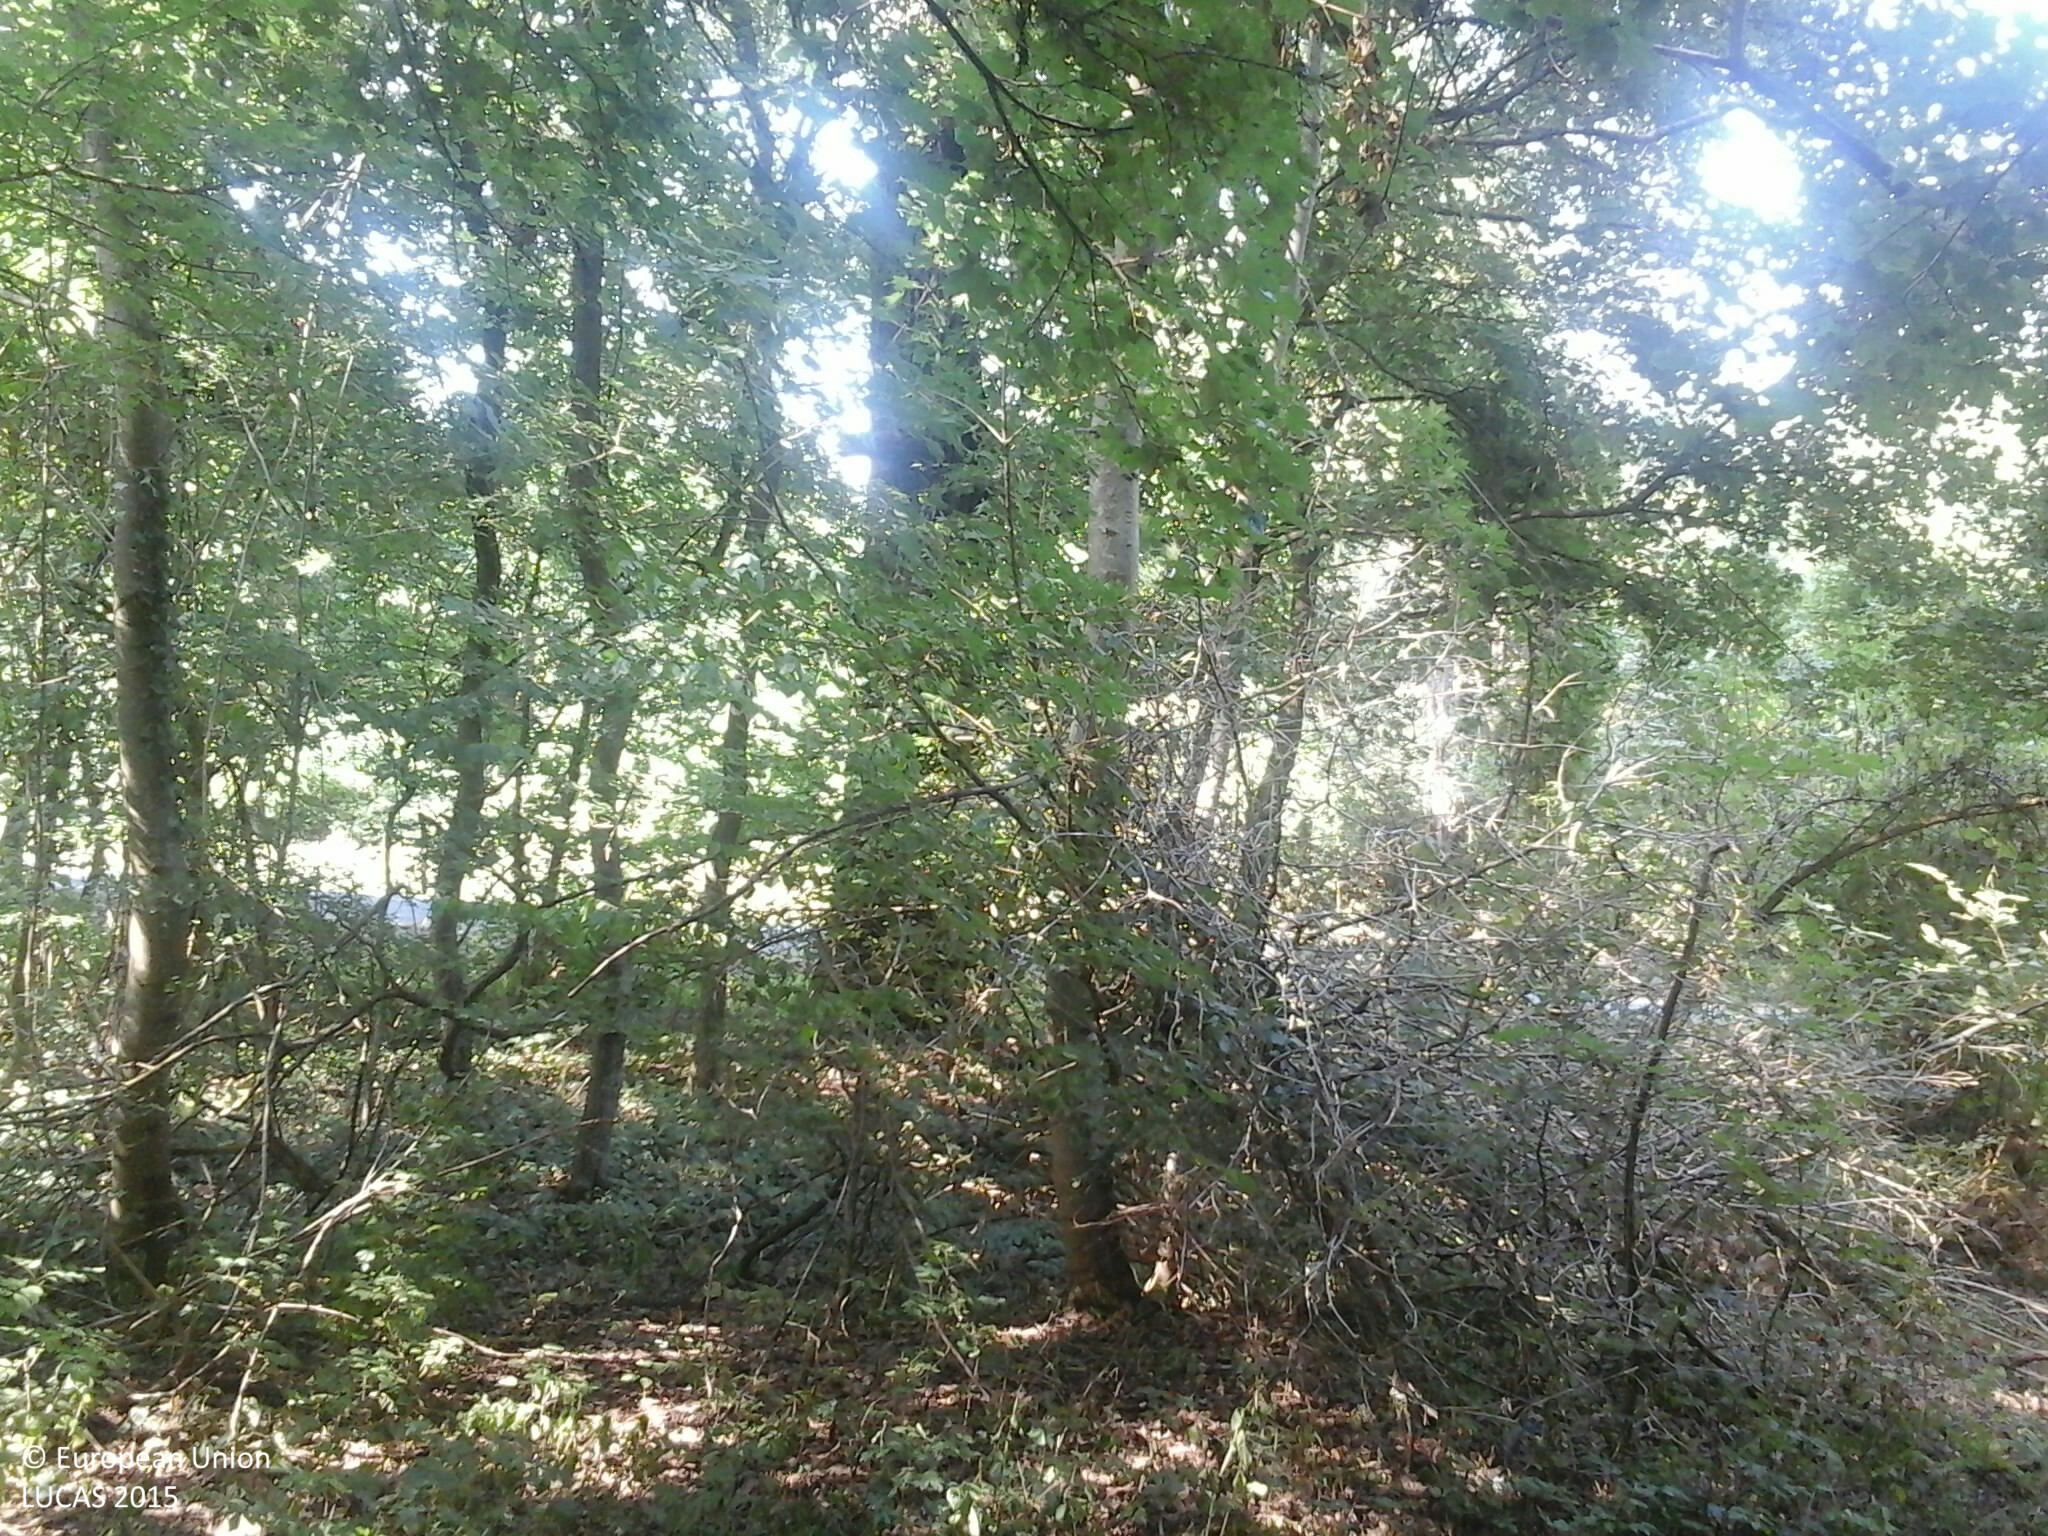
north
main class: Woodland
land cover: Broadleaved woodland
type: mesophytic deciduous forest
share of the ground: > 75 %
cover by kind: broadleaved forest trees 100 %
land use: Forestry
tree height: > 5 m
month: August
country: HU
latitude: 47.7072
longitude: 18.5848
